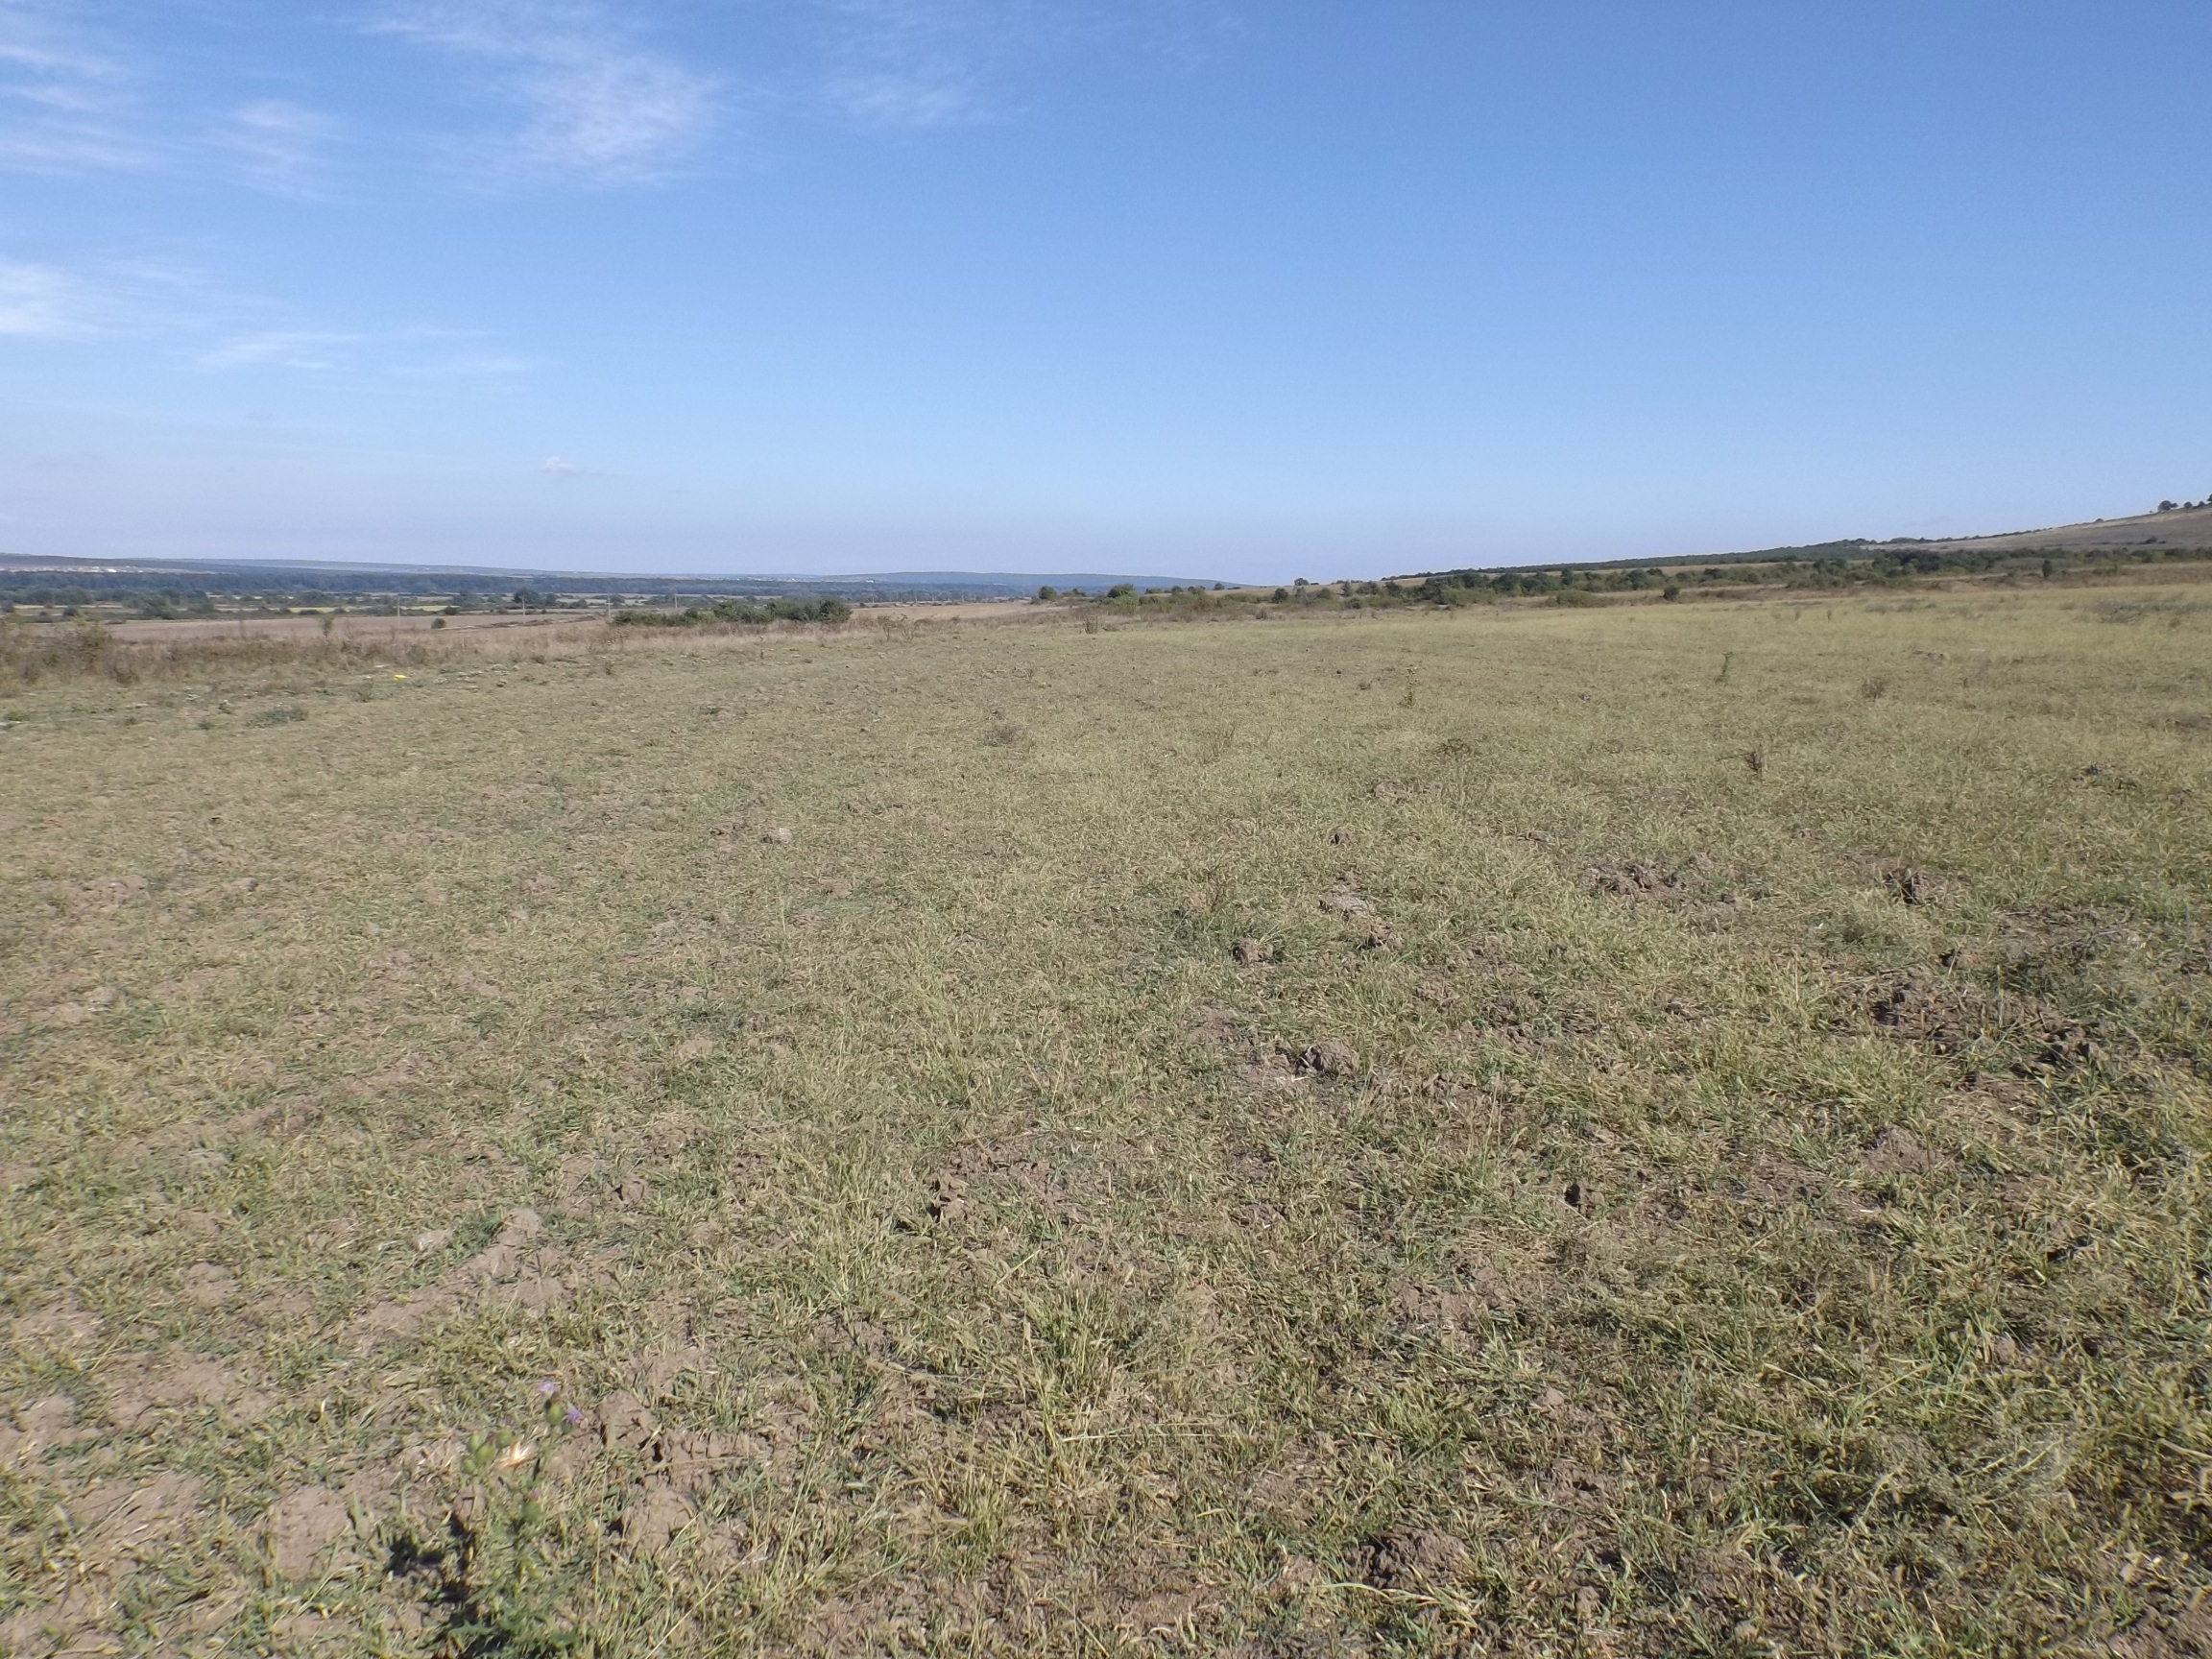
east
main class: Grassland
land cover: Spontaneously vegetated surfaces
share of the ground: 50 - 75 %
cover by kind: herbaceous plants 75 %, unconsolidated bare surface 25 %
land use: Fallow land
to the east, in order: Spontaneously vegetated surfaces; Ditches and canals; Spontaneously vegetated surfaces; Sunflower; Grassland without tree/shrub cover
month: September
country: BG
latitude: 43.0223
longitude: 27.5640
